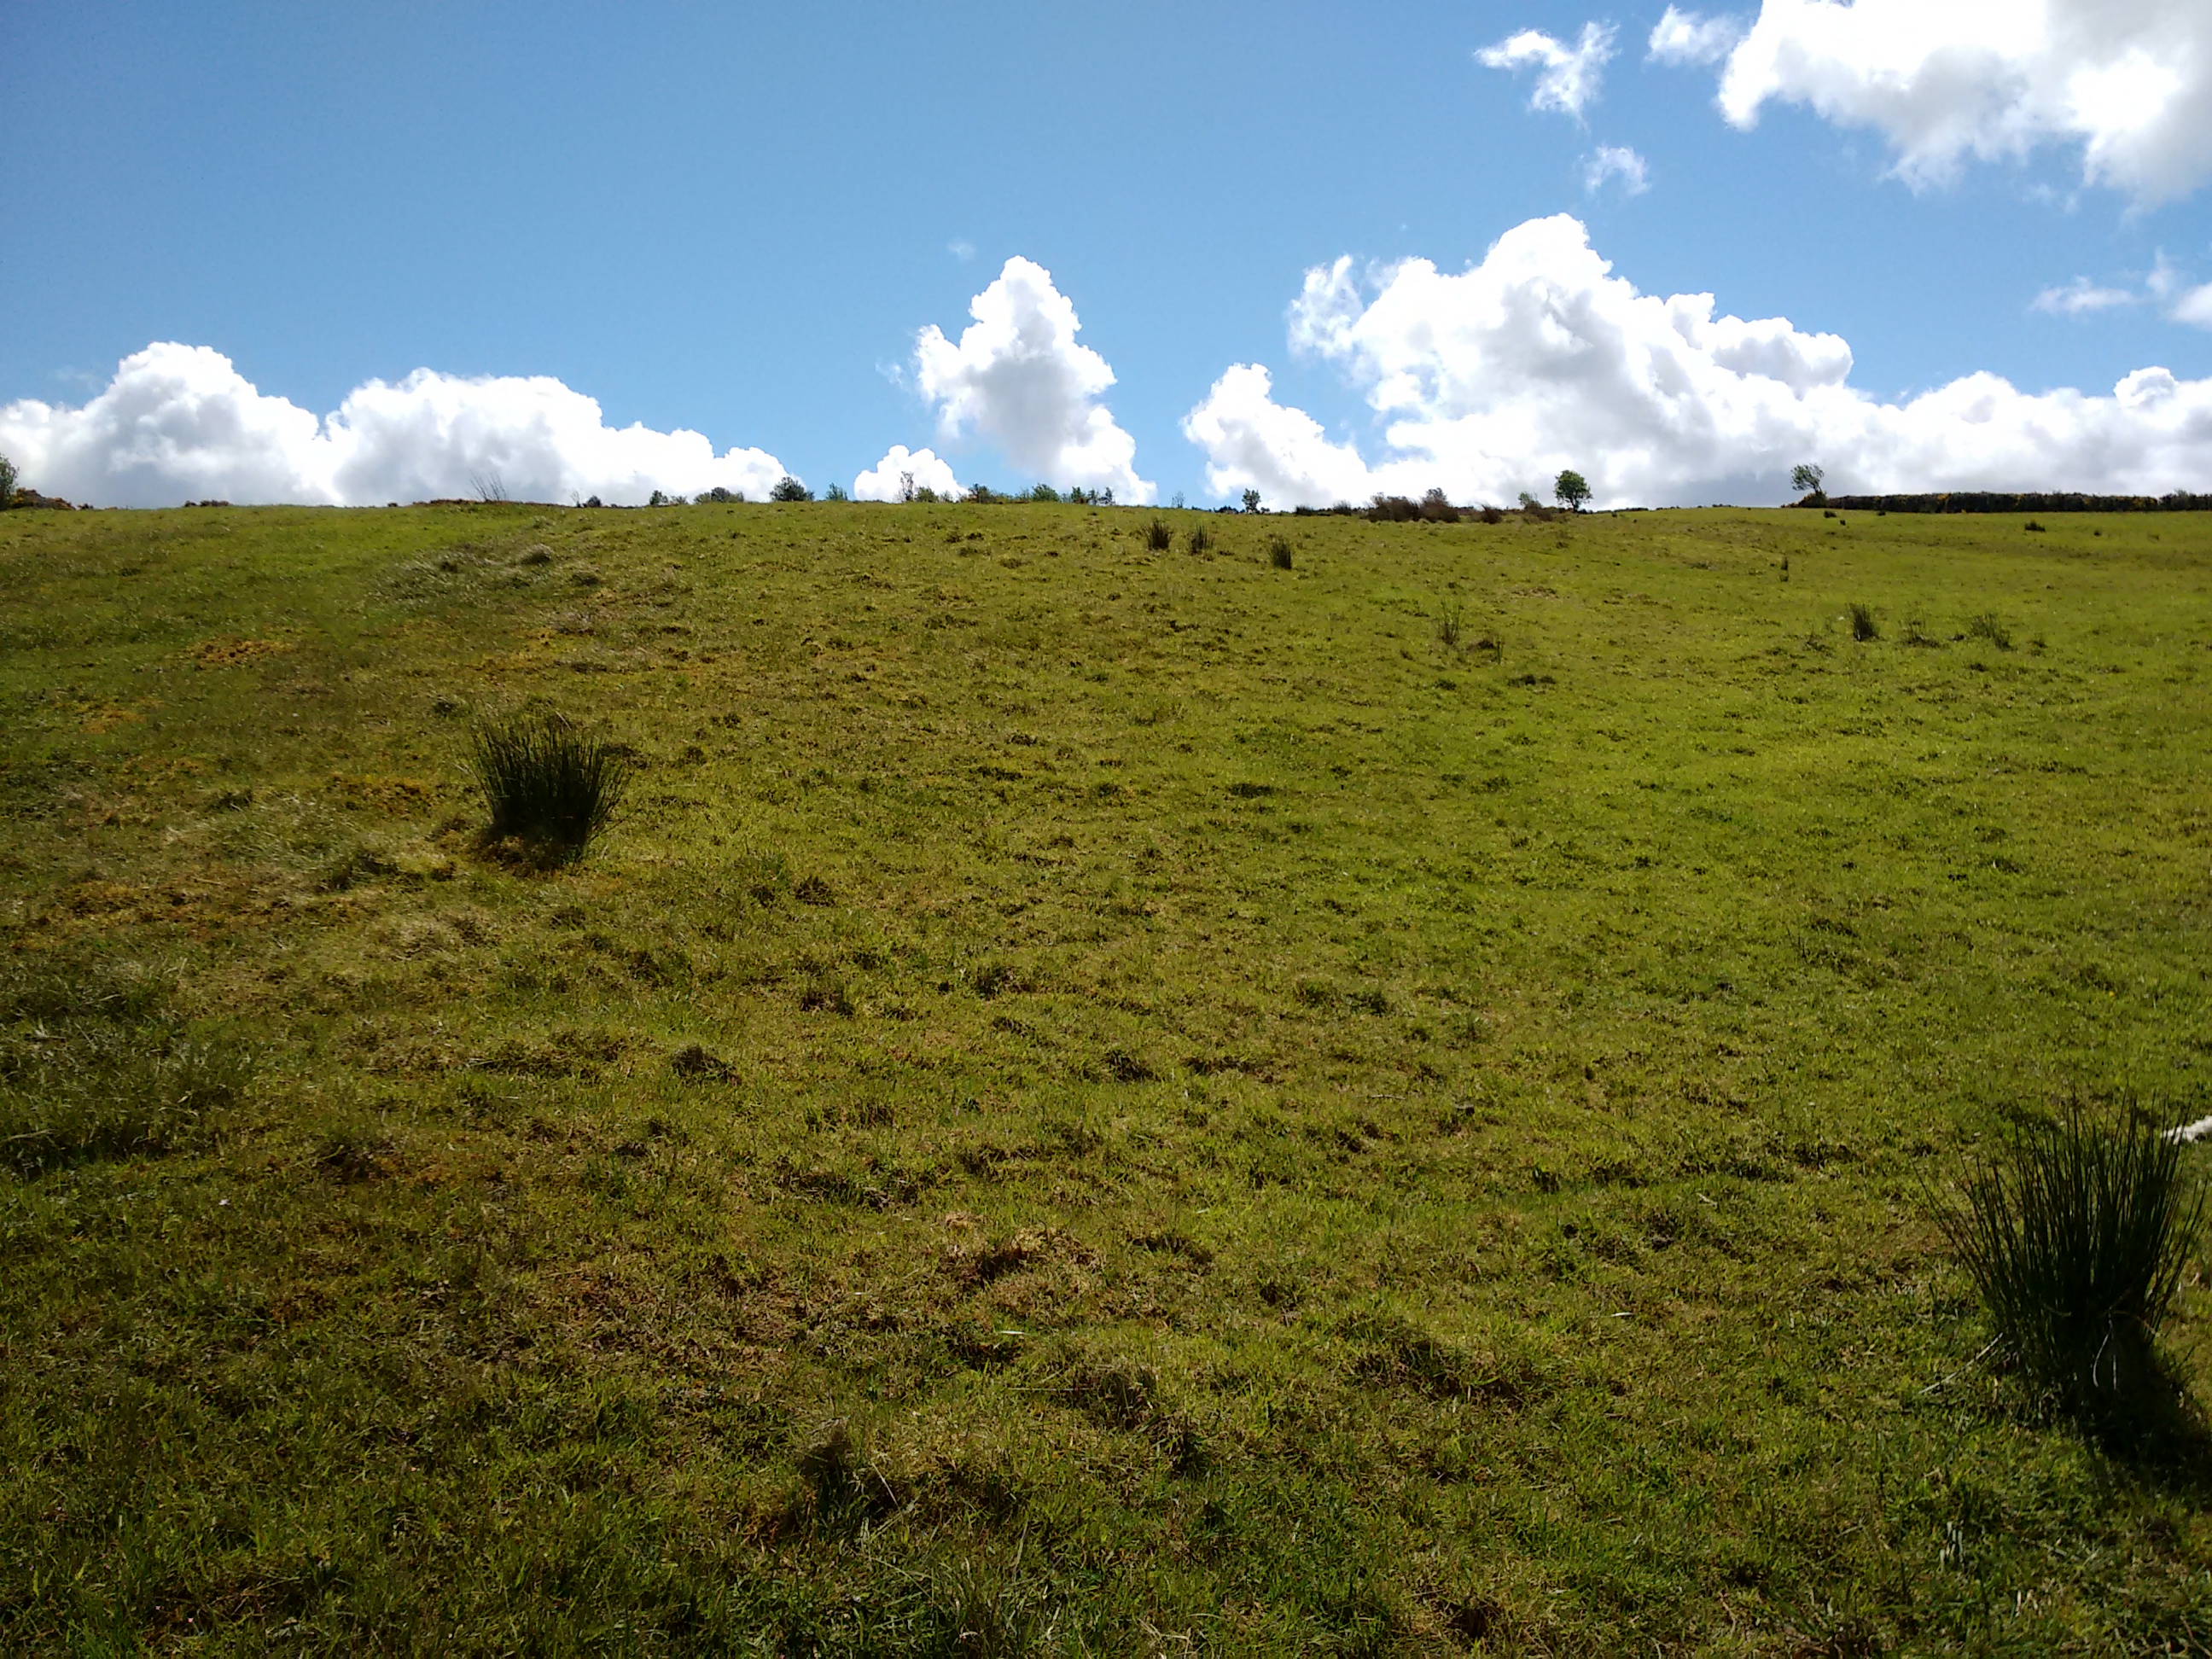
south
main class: Grassland
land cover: Grassland without tree/shrub cover
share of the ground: > 75 %
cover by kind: herbaceous plants 100 %
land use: Agriculture (excluding fallow land and kitchen gardens)
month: May
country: GB
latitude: 54.9246
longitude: -7.0382
